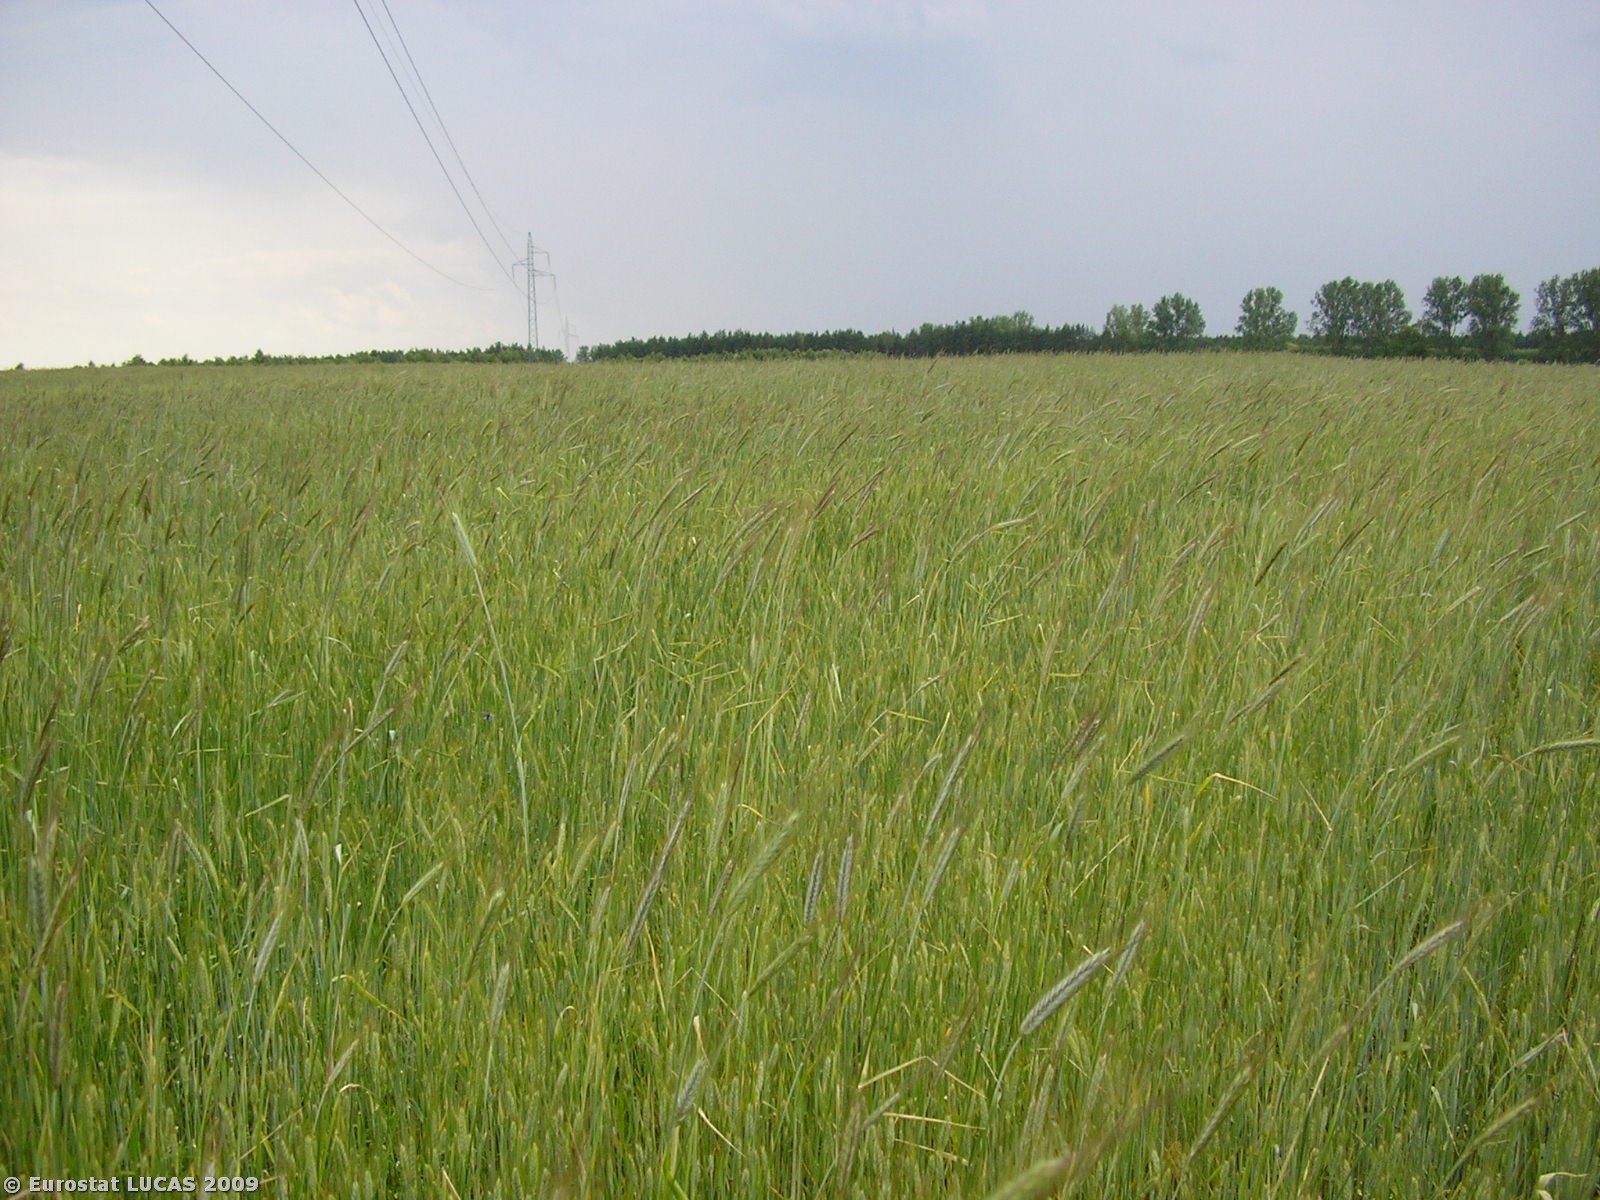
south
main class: Cropland
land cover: Triticale
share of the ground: 50 - 75 %
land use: Agriculture (excluding fallow land and kitchen gardens)
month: June
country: PL
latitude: 51.0849
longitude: 18.8878
